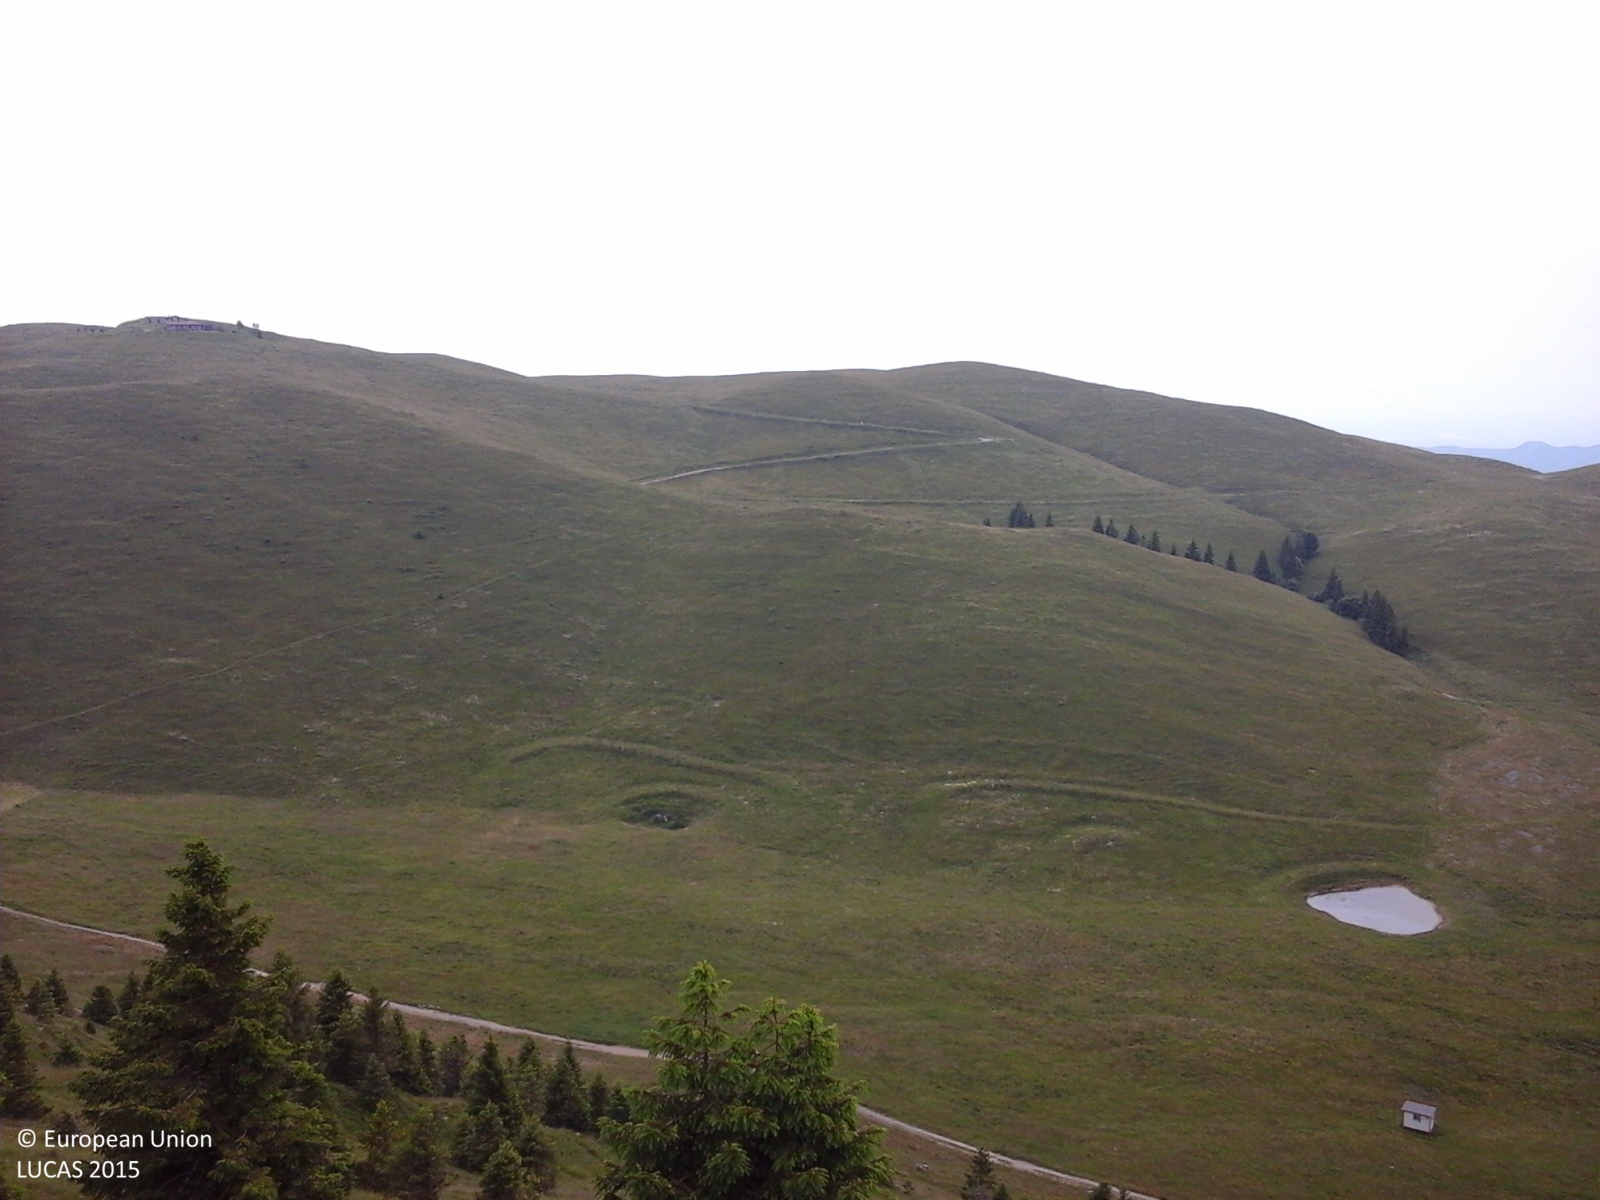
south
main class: Grassland
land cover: Grassland with sparse tree/shrub cover
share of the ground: > 75 %
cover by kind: herbaceous plants 90 %, coniferous forest trees 5 %, shrubs 5 %
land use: Agriculture (excluding fallow land and kitchen gardens)
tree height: < 5 m
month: June
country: IT
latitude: 45.8468
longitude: 9.9357
